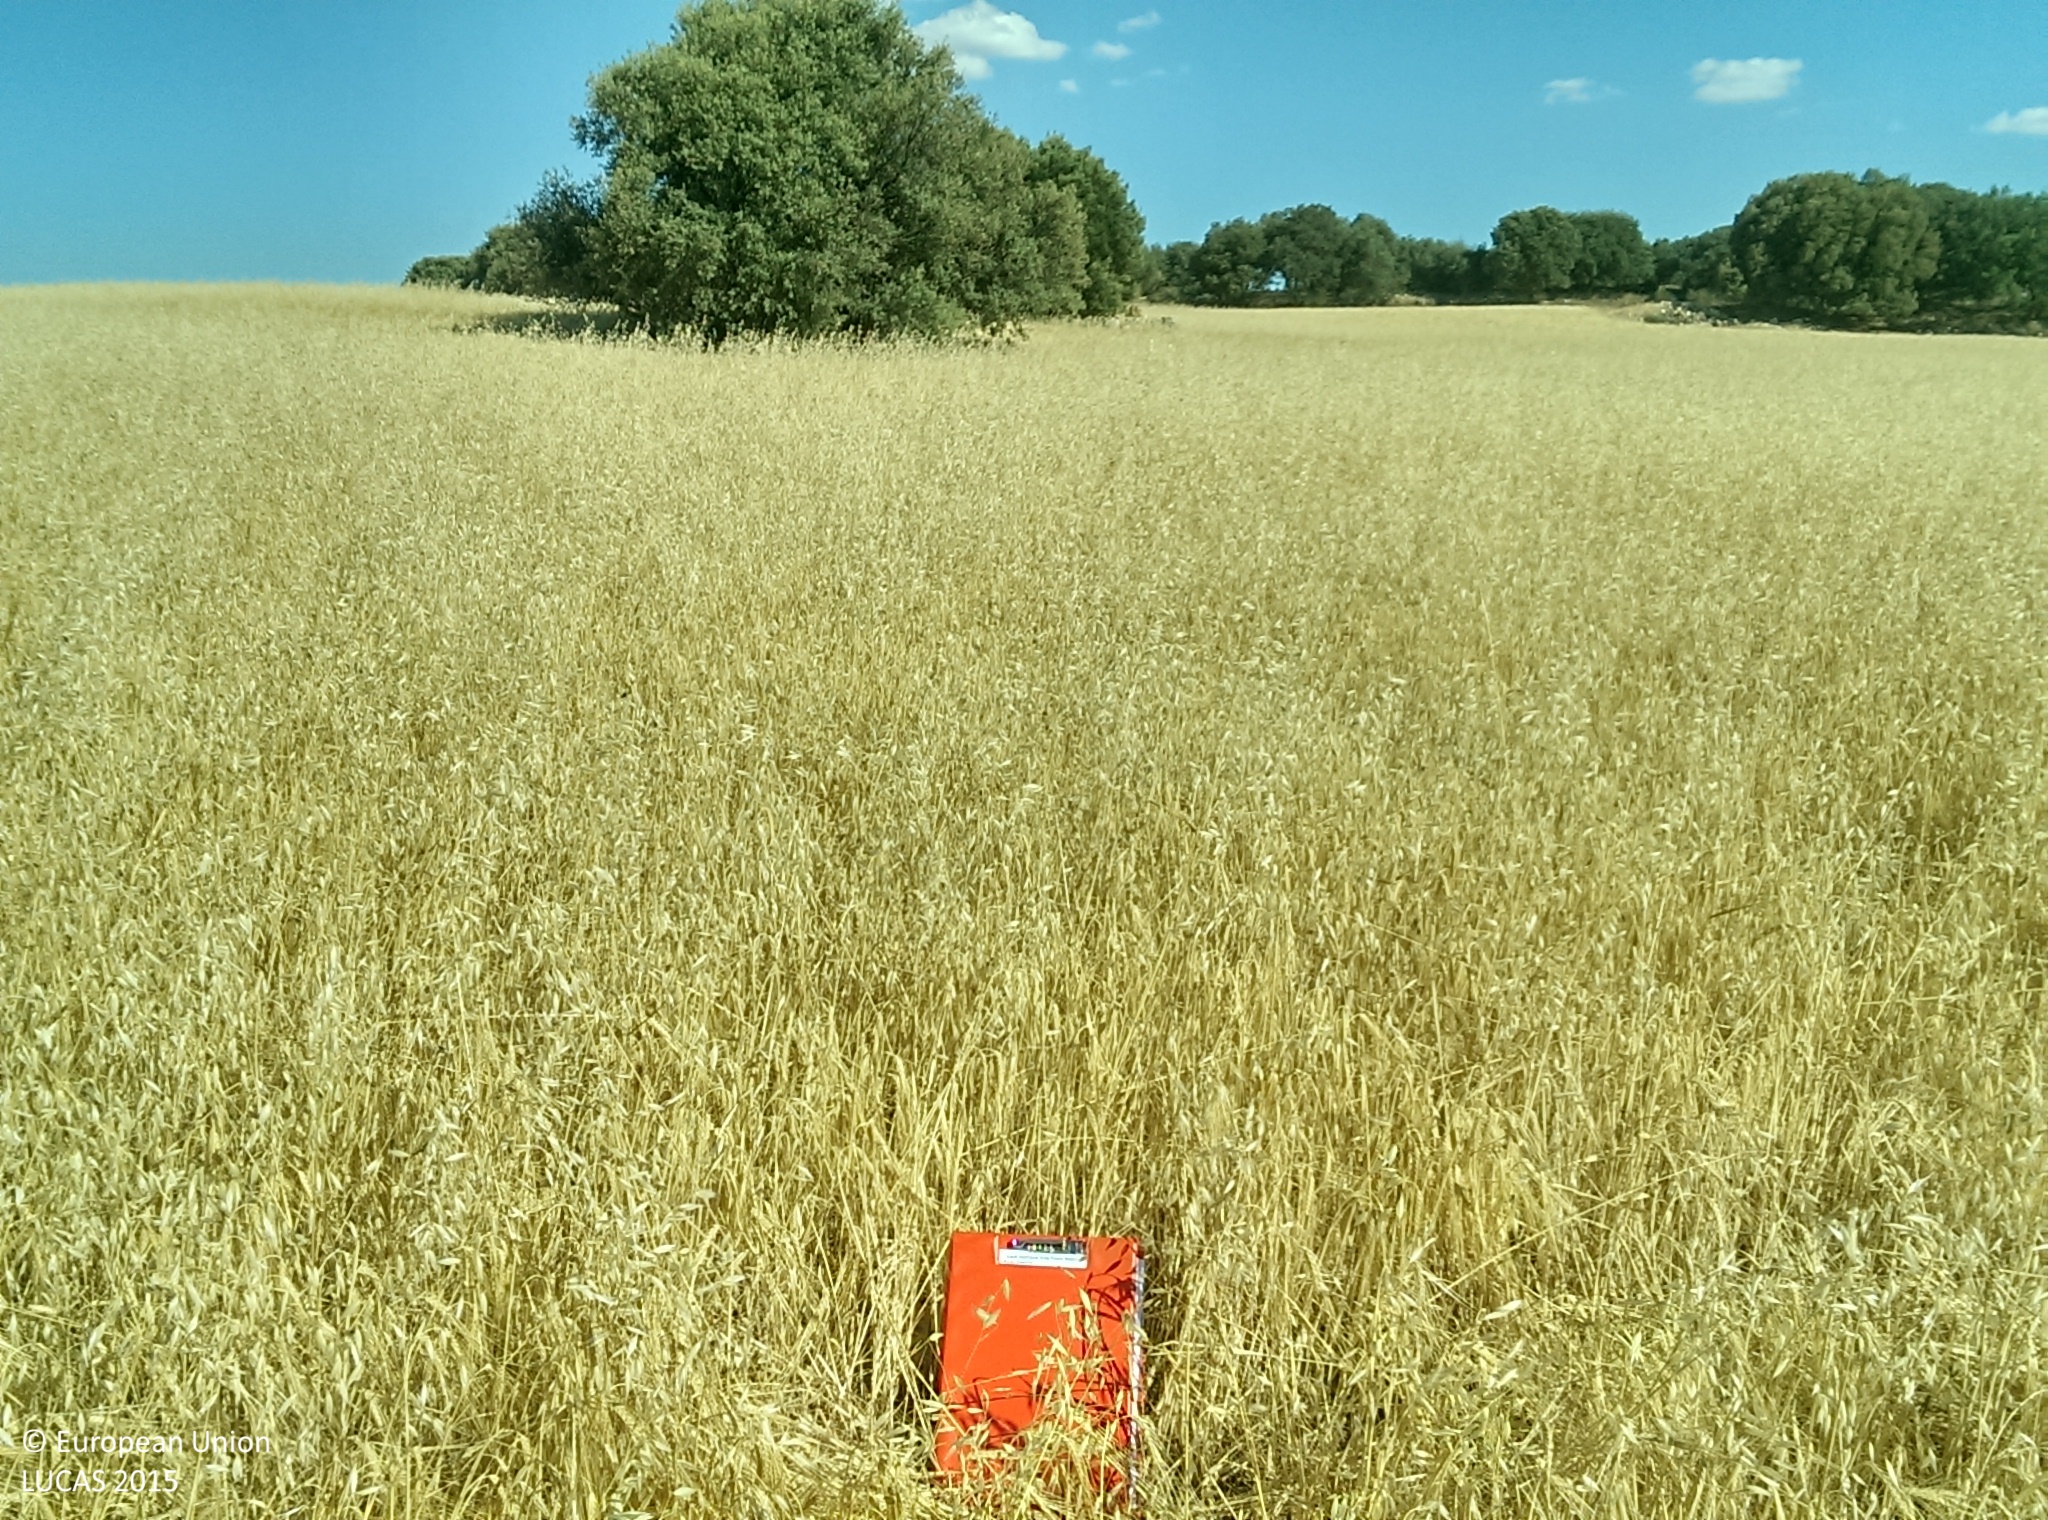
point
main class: Cropland
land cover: Barley
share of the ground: > 75 %
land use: Agriculture (excluding fallow land and kitchen gardens)
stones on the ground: < 10 %
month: June
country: ES
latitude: 37.5441
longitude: -3.2911
